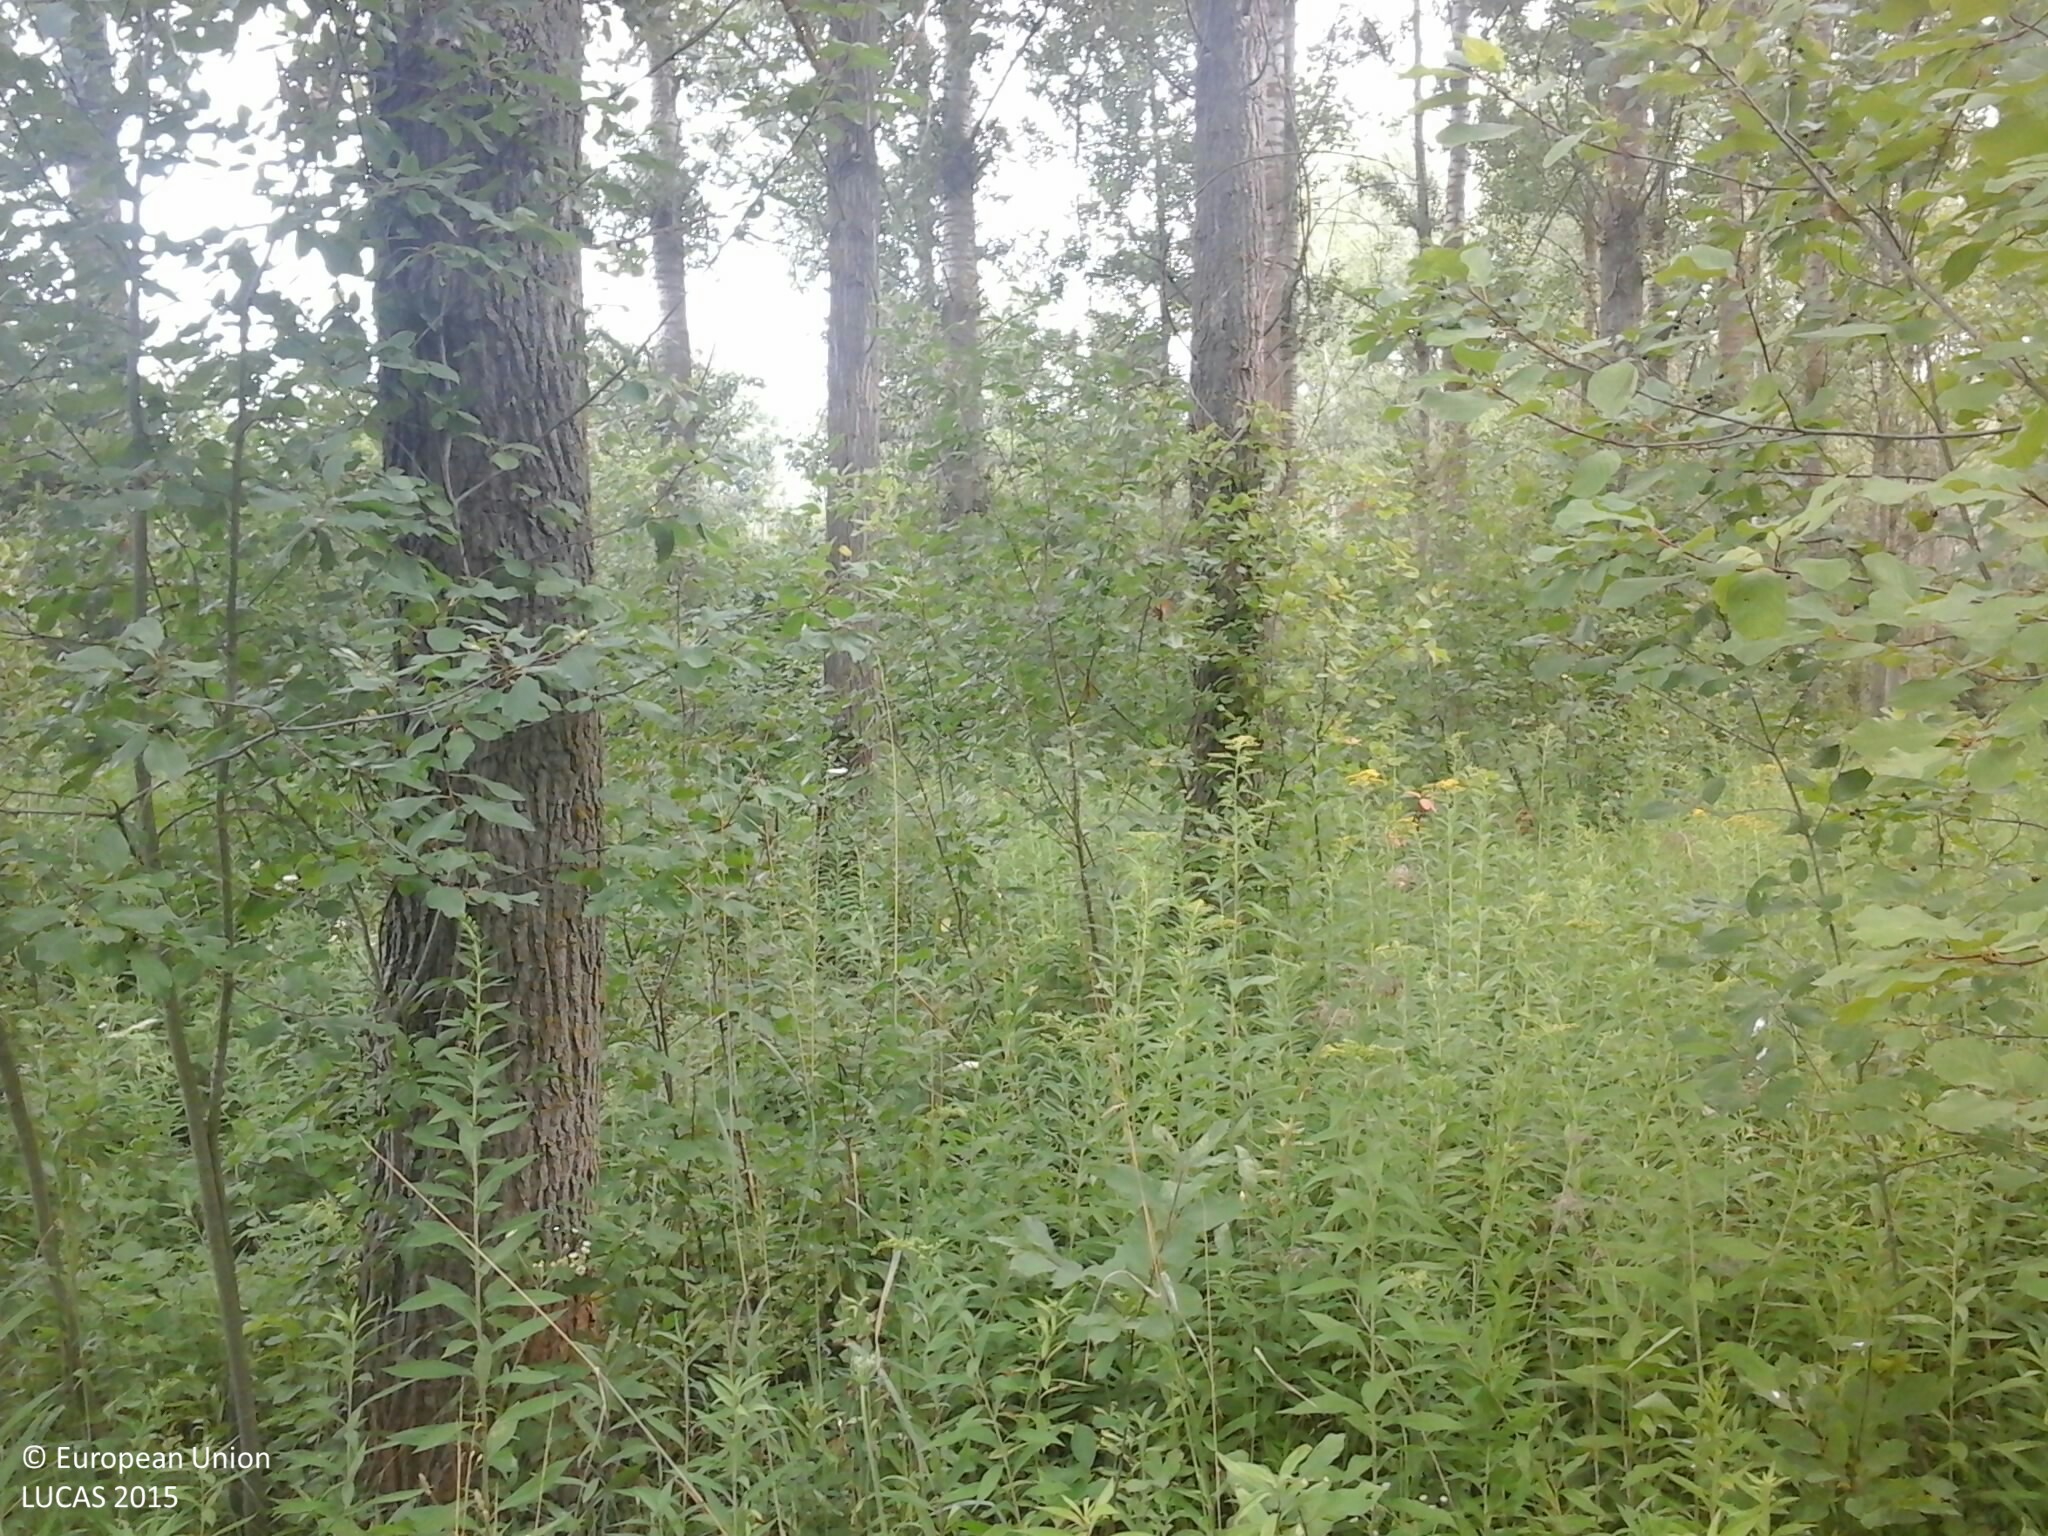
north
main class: Woodland
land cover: Broadleaved woodland
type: non-riverine alder, birch or aspen forest
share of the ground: > 75 %
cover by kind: broadleaved forest trees 80 %, shrubs 10 %, herbaceous plants 10 %
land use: Forestry
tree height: > 5 m
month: July
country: HU
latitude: 47.7428
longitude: 22.2034
